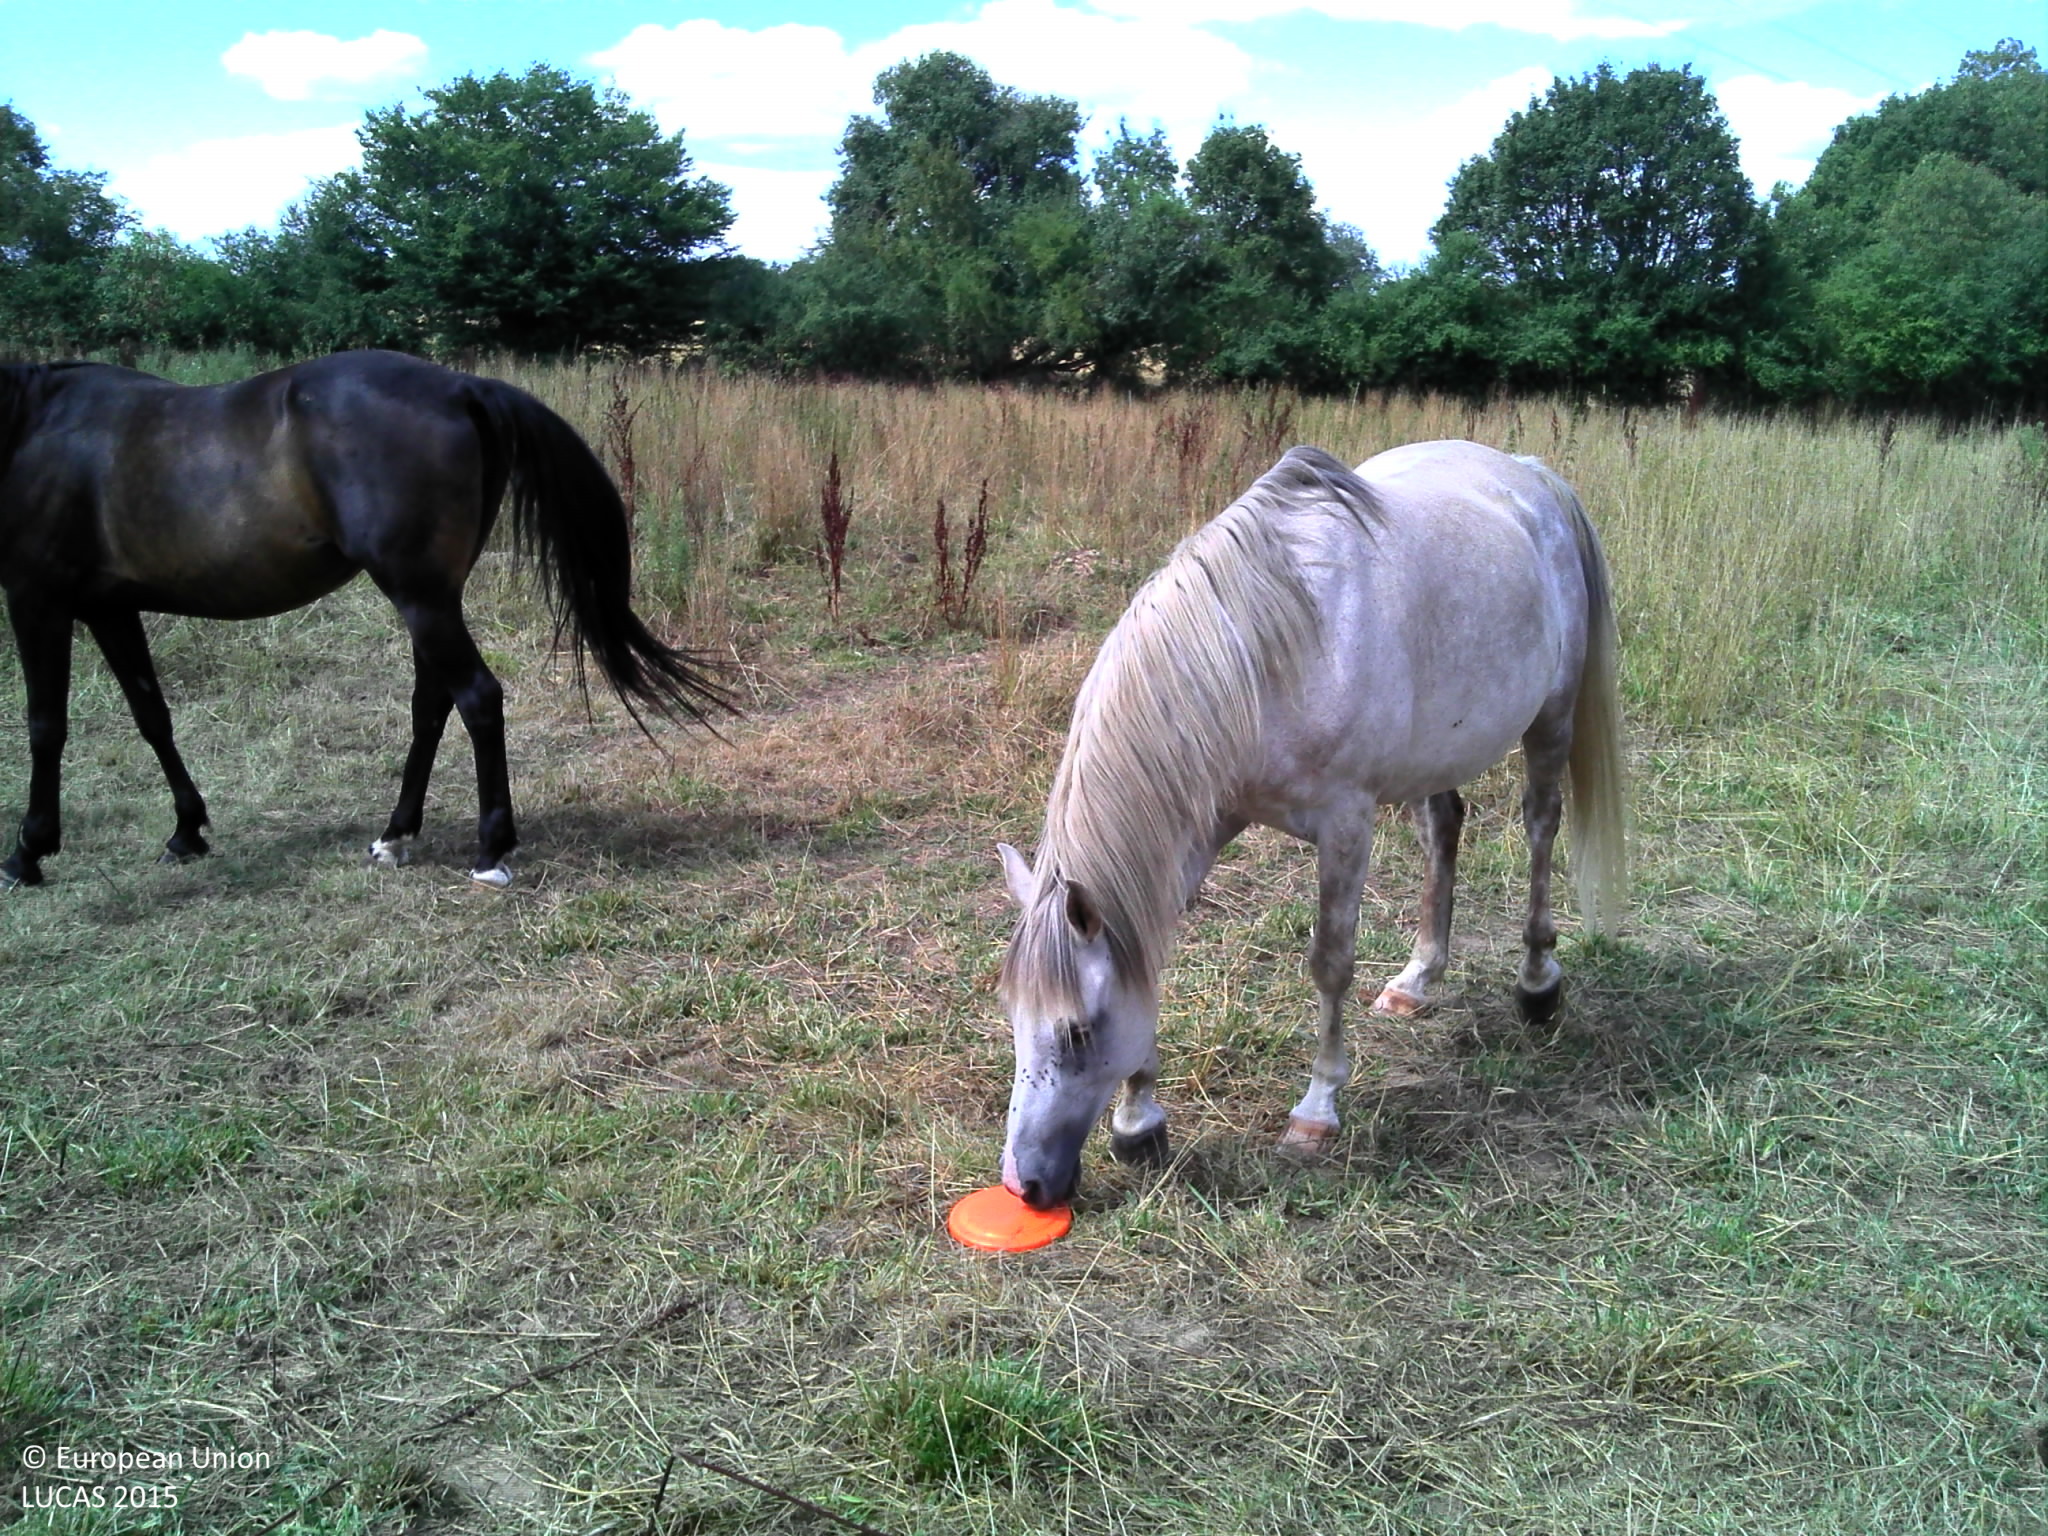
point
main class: Grassland
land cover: Grassland without tree/shrub cover
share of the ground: > 75 %
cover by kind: herbaceous plants 80 %, unconsolidated bare surface 20 %
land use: Agriculture (excluding fallow land and kitchen gardens)
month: July
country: FR
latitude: 47.8259
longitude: 3.0878
